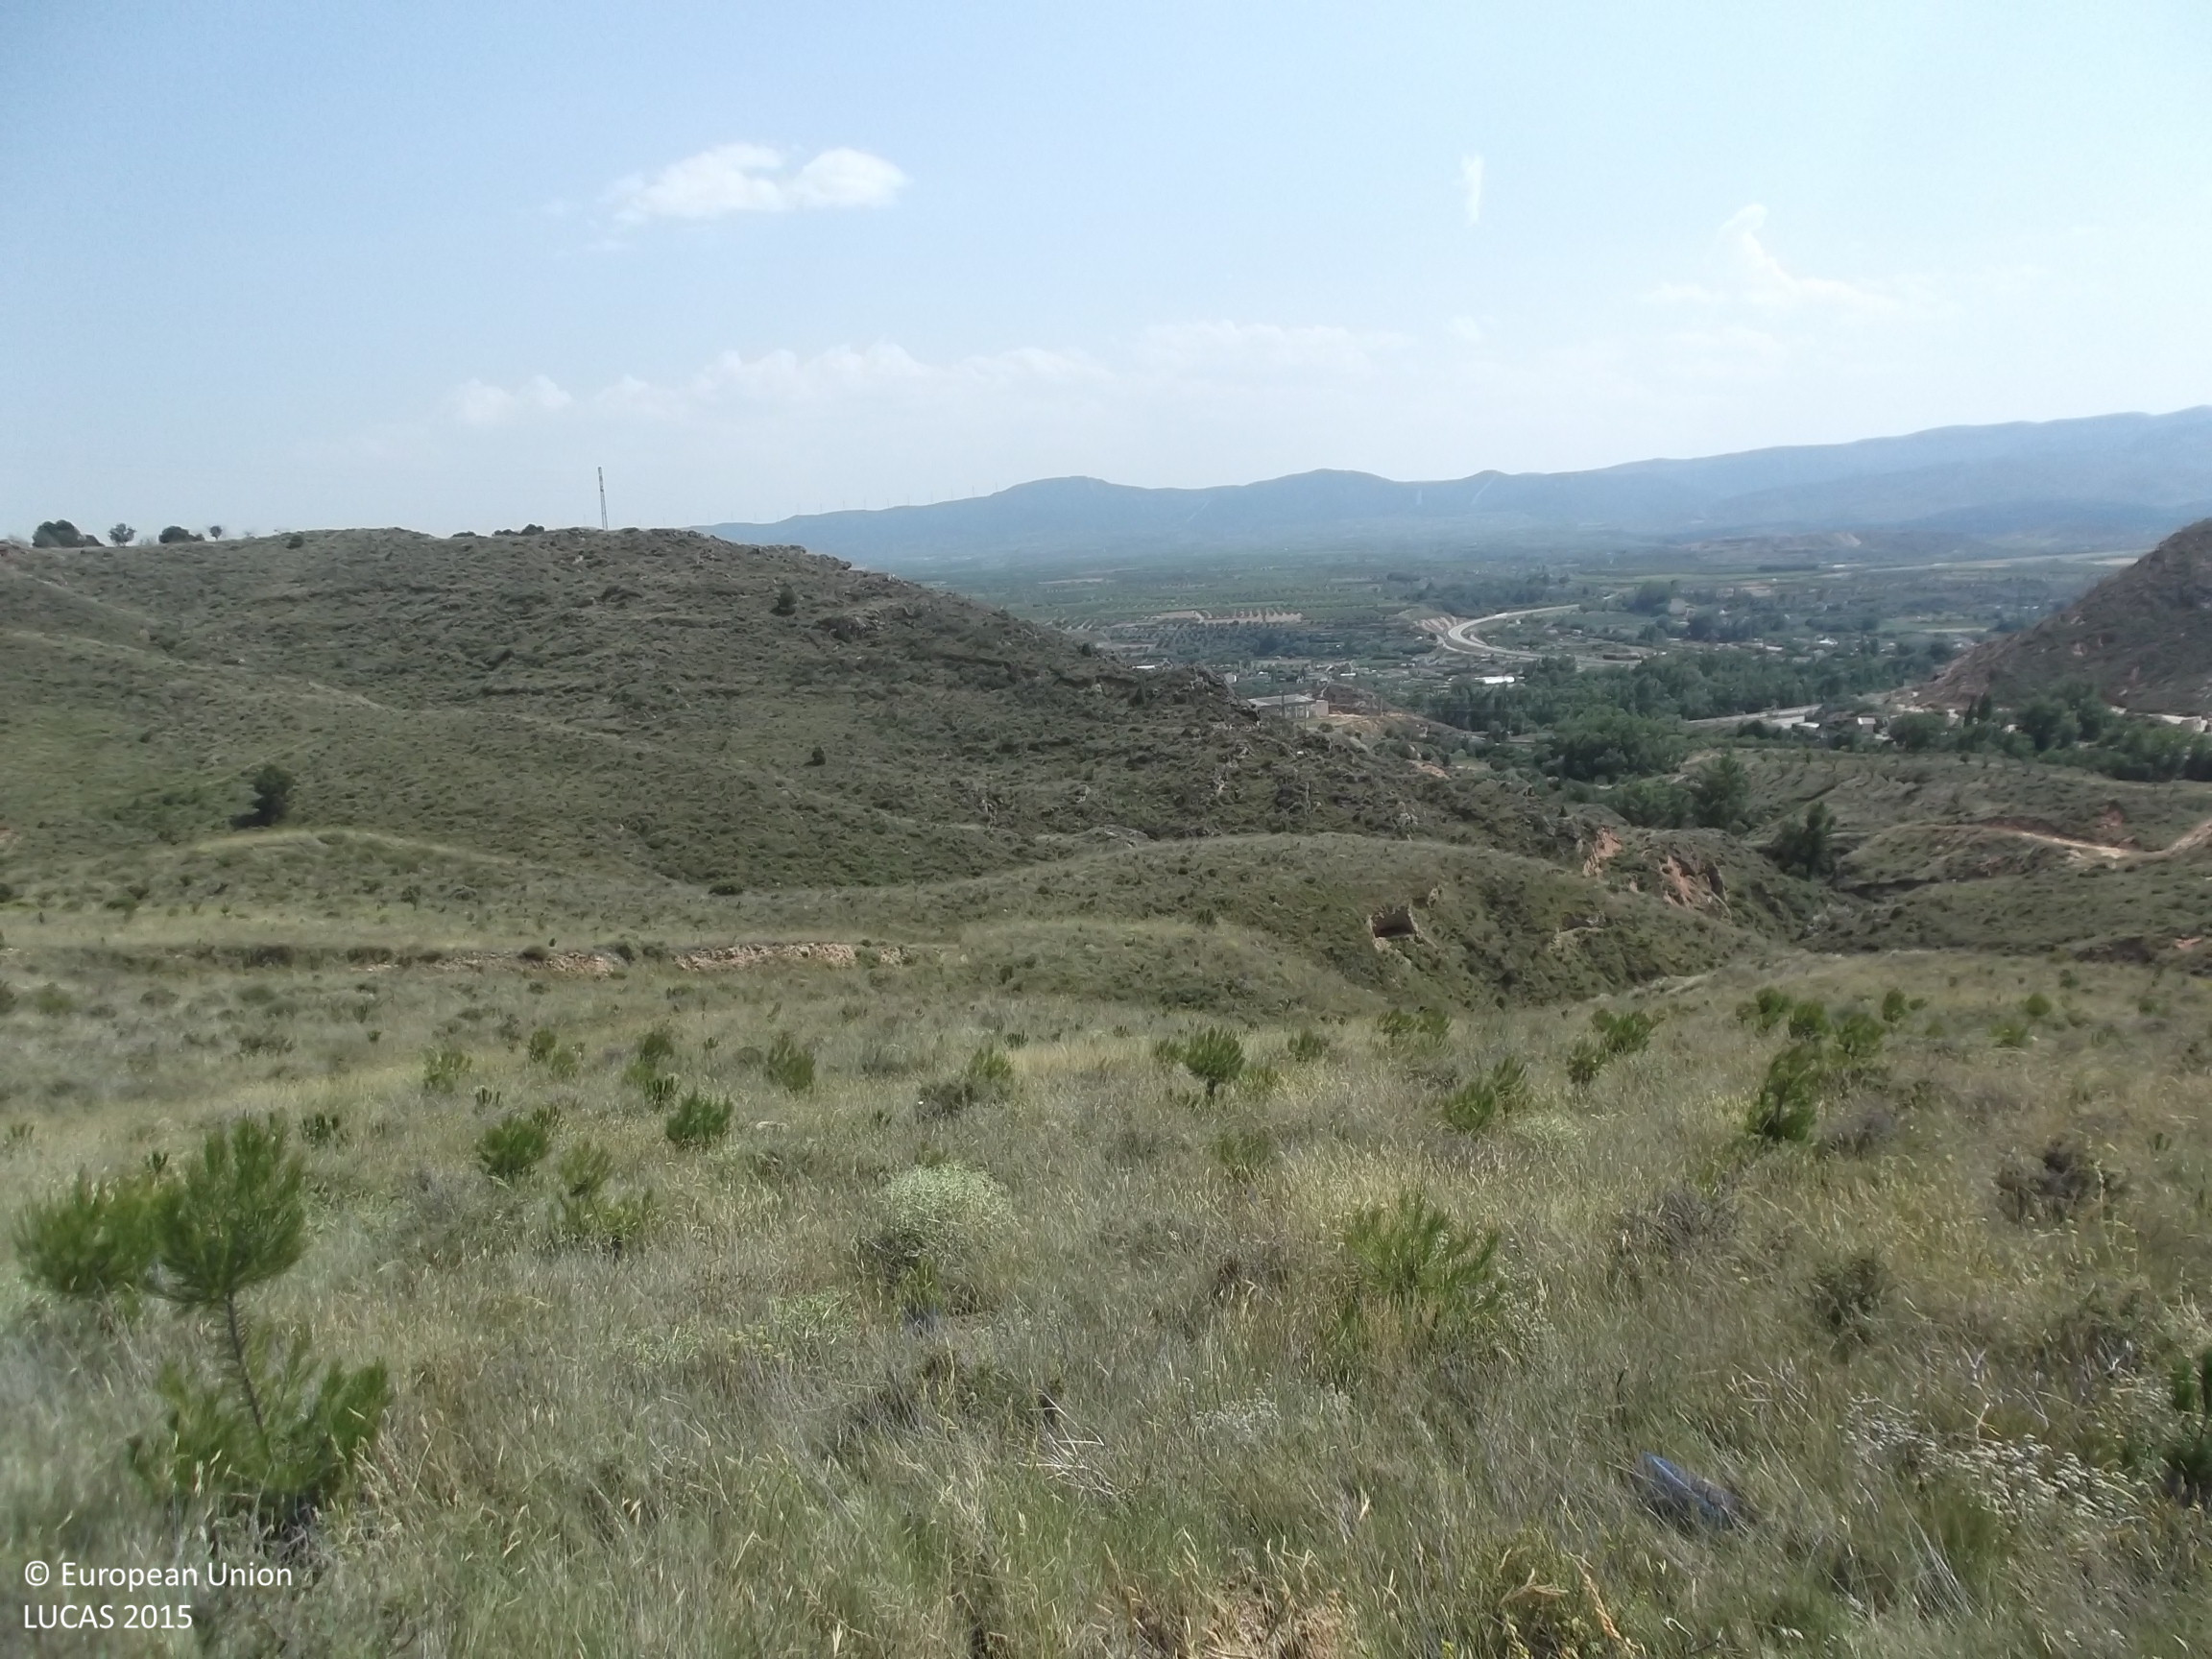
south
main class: Woodland
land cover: Pine dominated coniferous woodland
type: coniferous forest of the mediterranean region
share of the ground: 10 - 25 %
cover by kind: shrubs 70 %, coniferous forest trees 10 %, herbaceous plants 10 %, unconsolidated bare surface 10 %
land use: Forestry
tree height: < 5 m
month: June
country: ES
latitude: 42.2393
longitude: -2.0718
